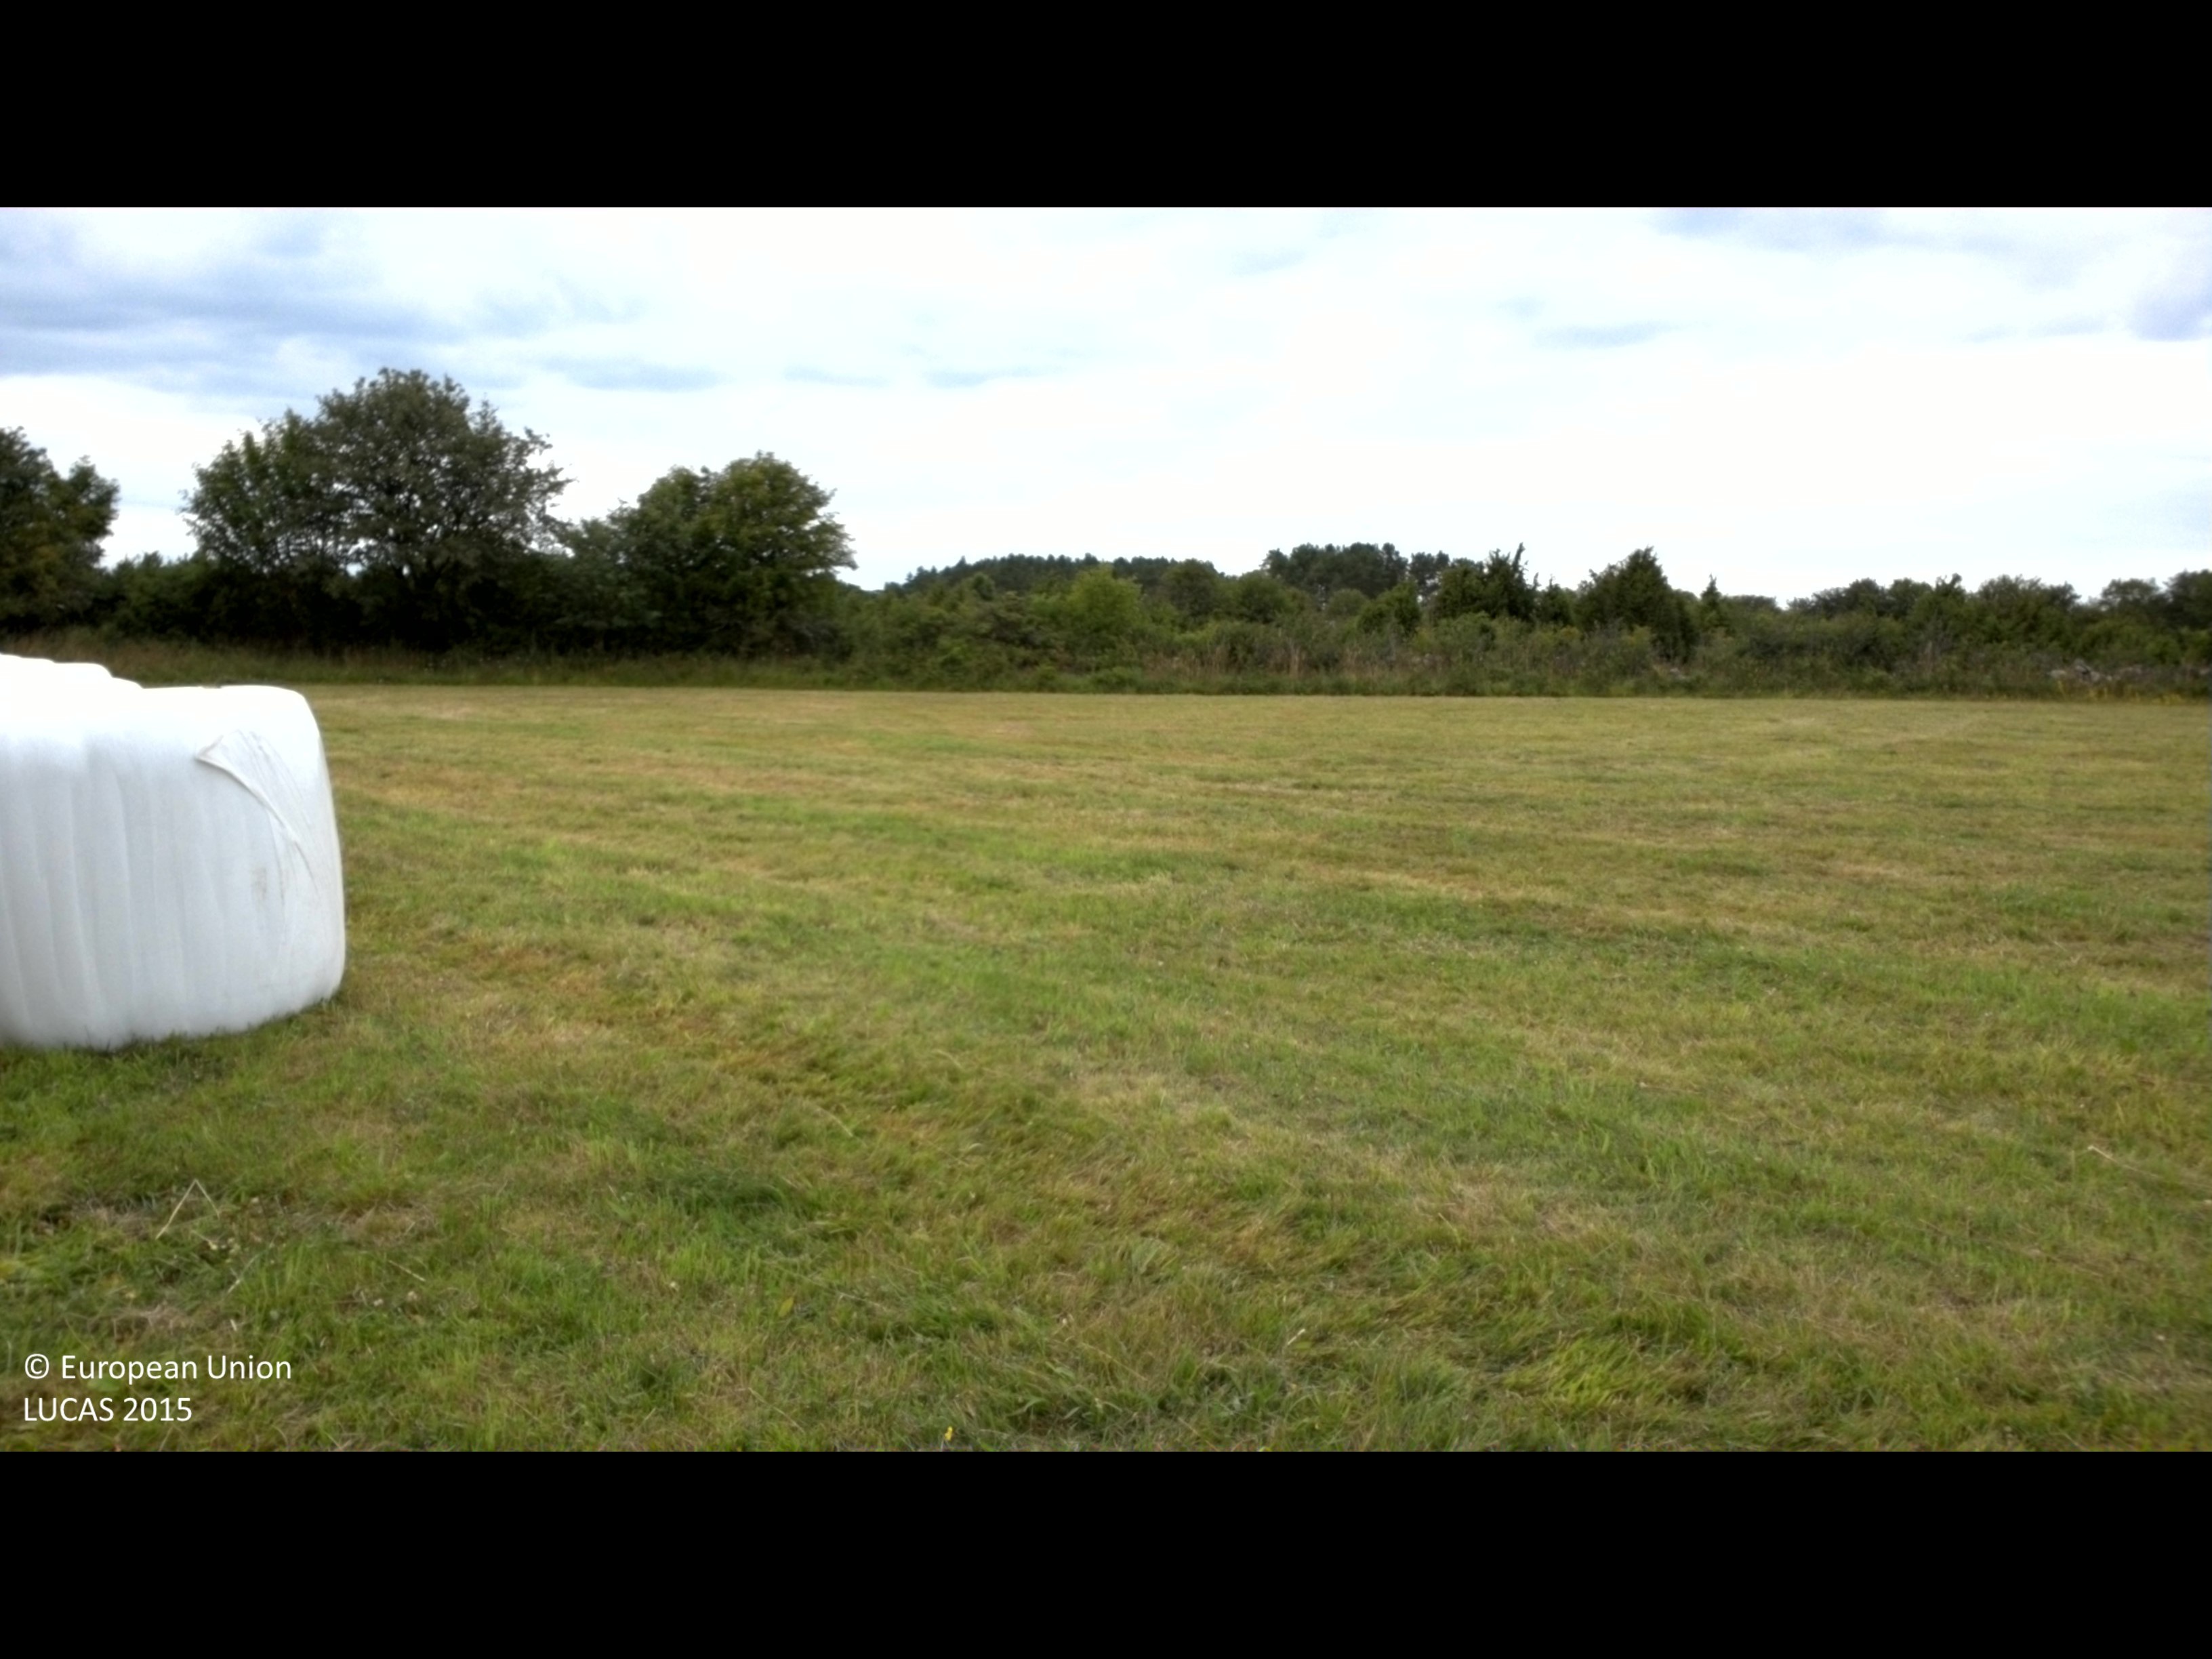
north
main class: Shrubland
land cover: Shrubland without tree cover
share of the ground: > 75 %
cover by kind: shrubs 100 %
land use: Semi-natural and natural areas not in use
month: July
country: SE
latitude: 57.1167
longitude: 16.9876
